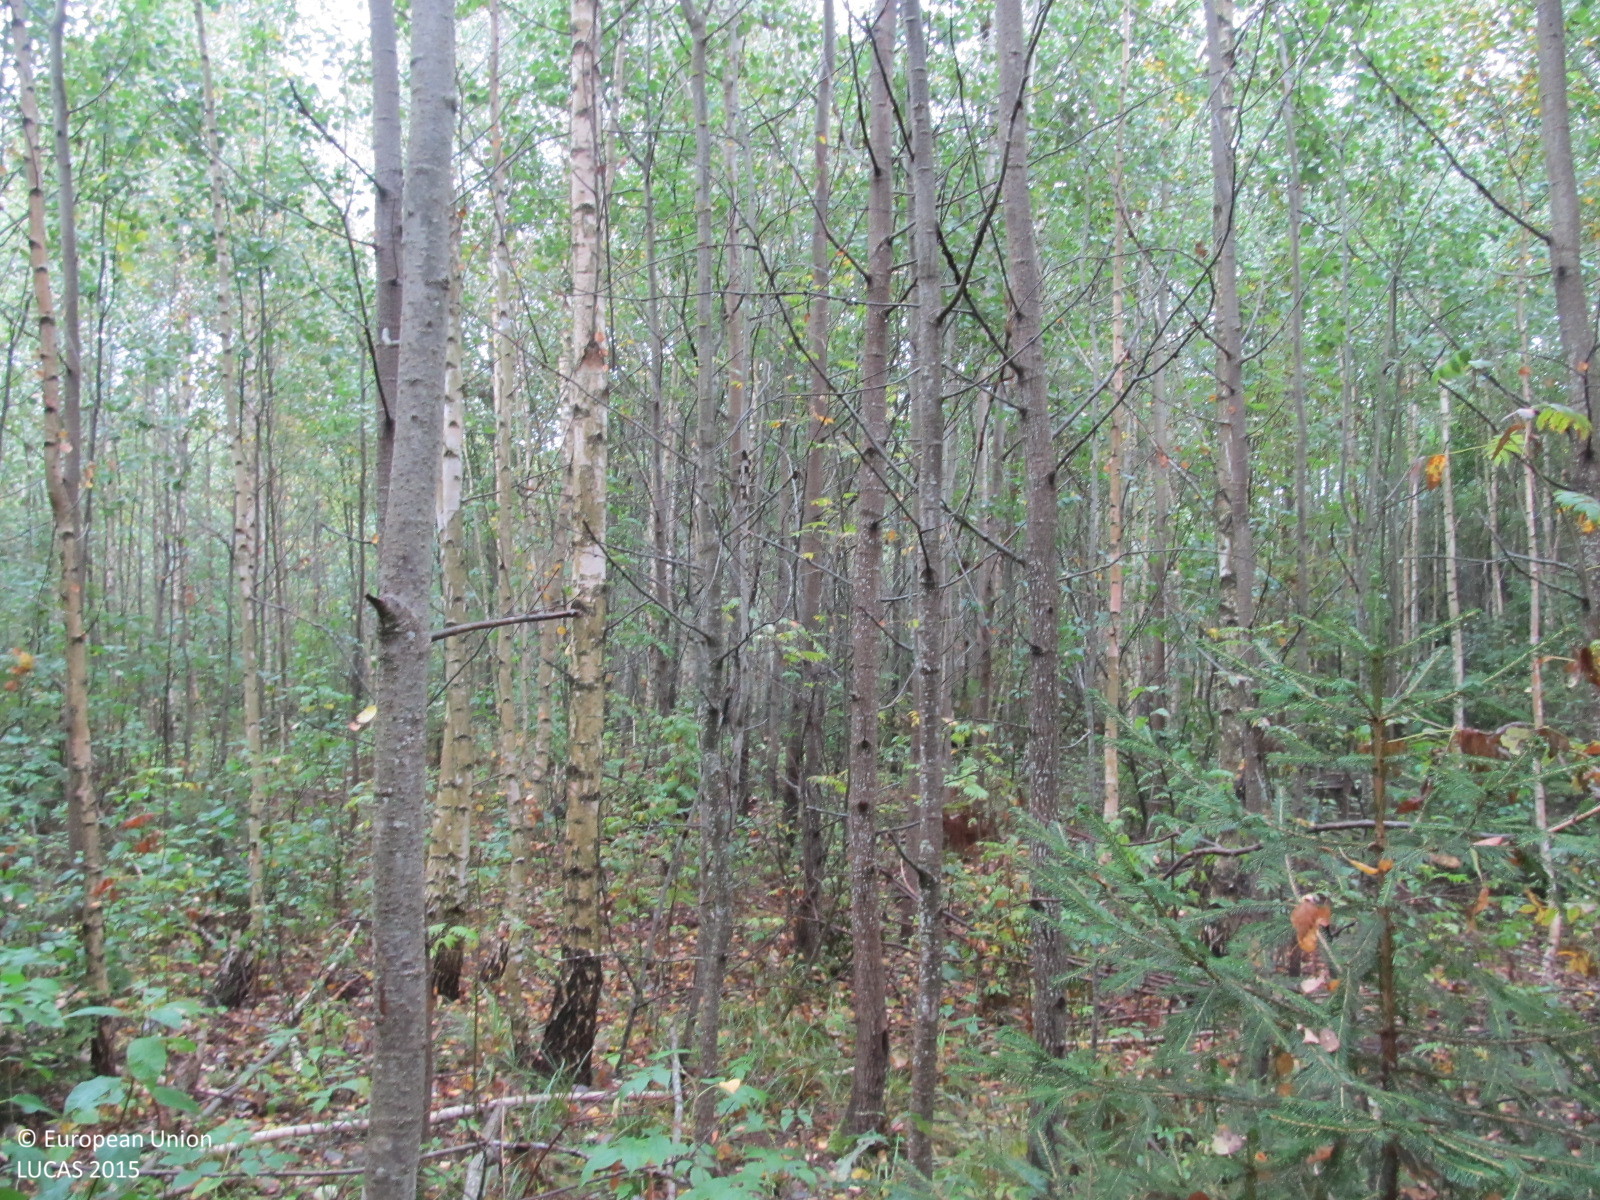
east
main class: Woodland
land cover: Broadleaved woodland
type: non-riverine alder, birch or aspen forest
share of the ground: > 75 %
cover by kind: broadleaved forest trees 75 %, coniferous forest trees 5 %, shrubs 5 %, herbaceous plants 5 %, lichens and mosses 5 %, unconsolidated bare surface 5 %
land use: Forestry
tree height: > 5 m
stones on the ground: < 10 %
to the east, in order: Broadleaved woodland; Spontaneously vegetated surfaces; Tracks; Common wheat
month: September
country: LT
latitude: 55.9883
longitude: 22.9062
